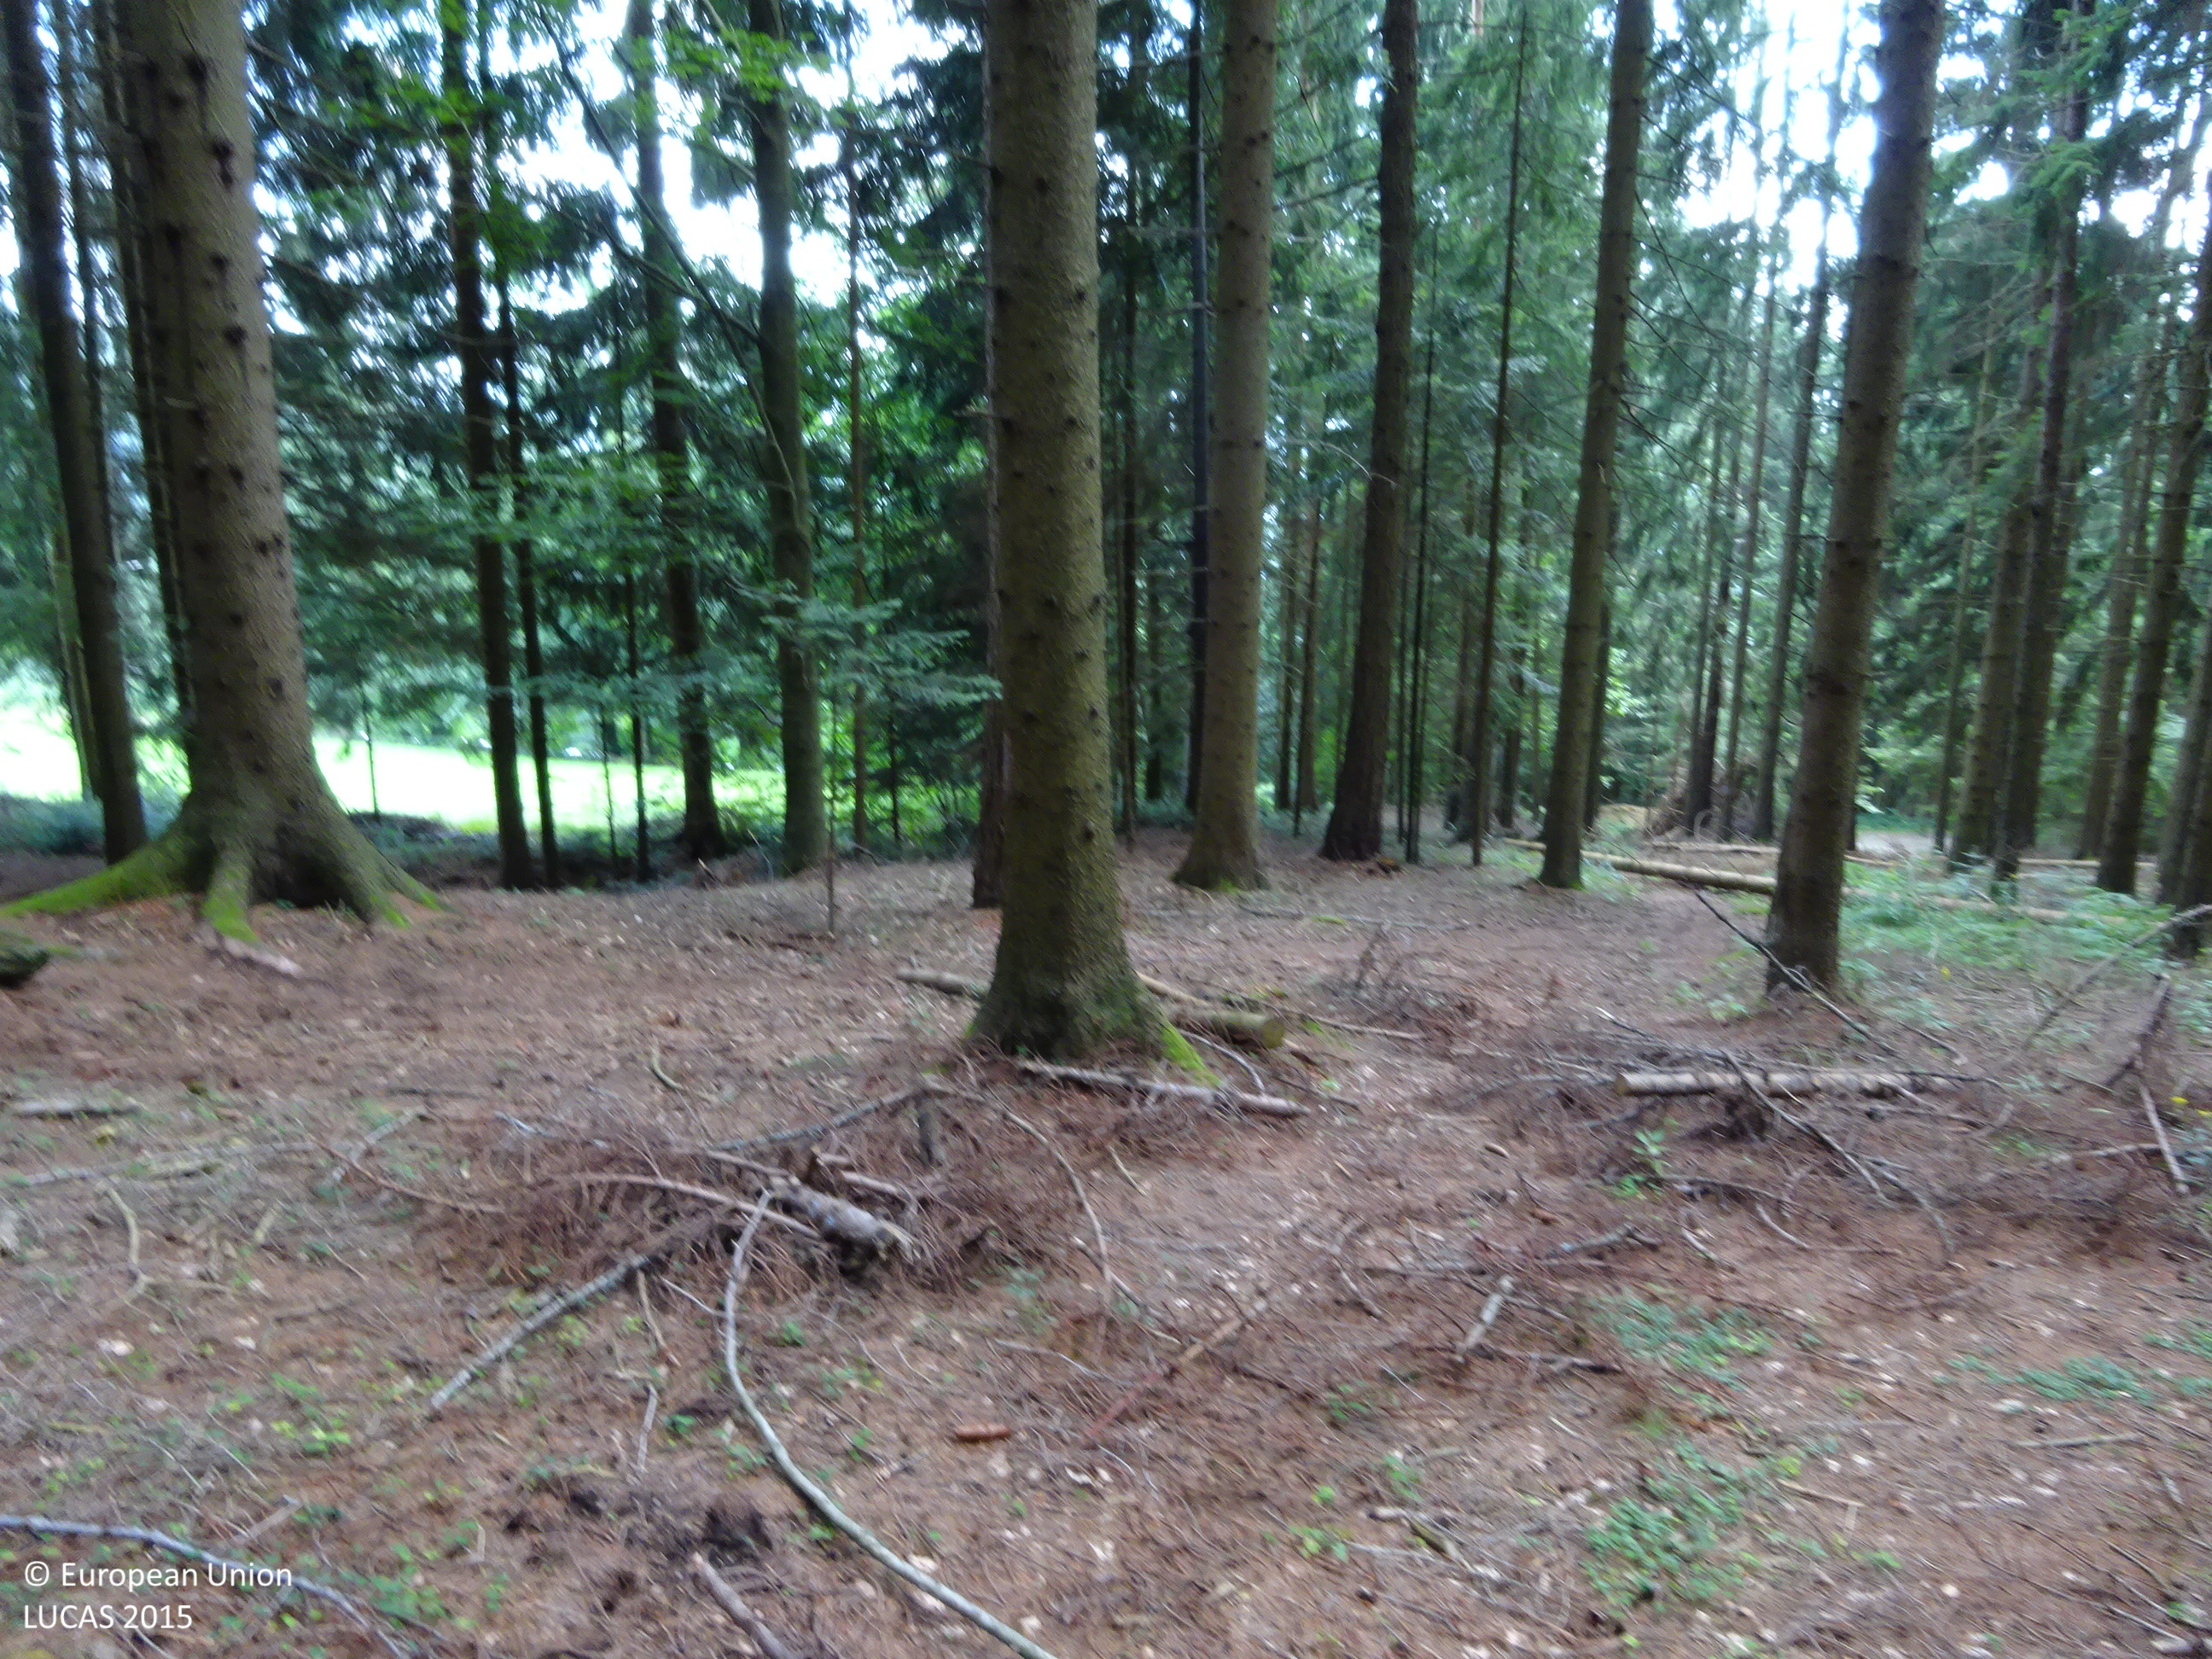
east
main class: Woodland
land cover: Spruce dominated coniferous woodland
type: alpine coniferous forest
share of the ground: > 75 %
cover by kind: coniferous forest trees 90 %, unconsolidated bare surface 10 %
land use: Forestry
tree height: > 5 m
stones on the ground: < 10 %
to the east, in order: Spruce dominated coniferous woodland; Grassland without tree/shrub cover; Tracks; Spruce dominated mixed woodland; Grassland without tree/shrub cover; Spruce dominated mixed woodland; Tracks; Spruce dominated mixed woodland; Spontaneously vegetated surfaces
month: August
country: AT
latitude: 47.3513
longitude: 15.7597
